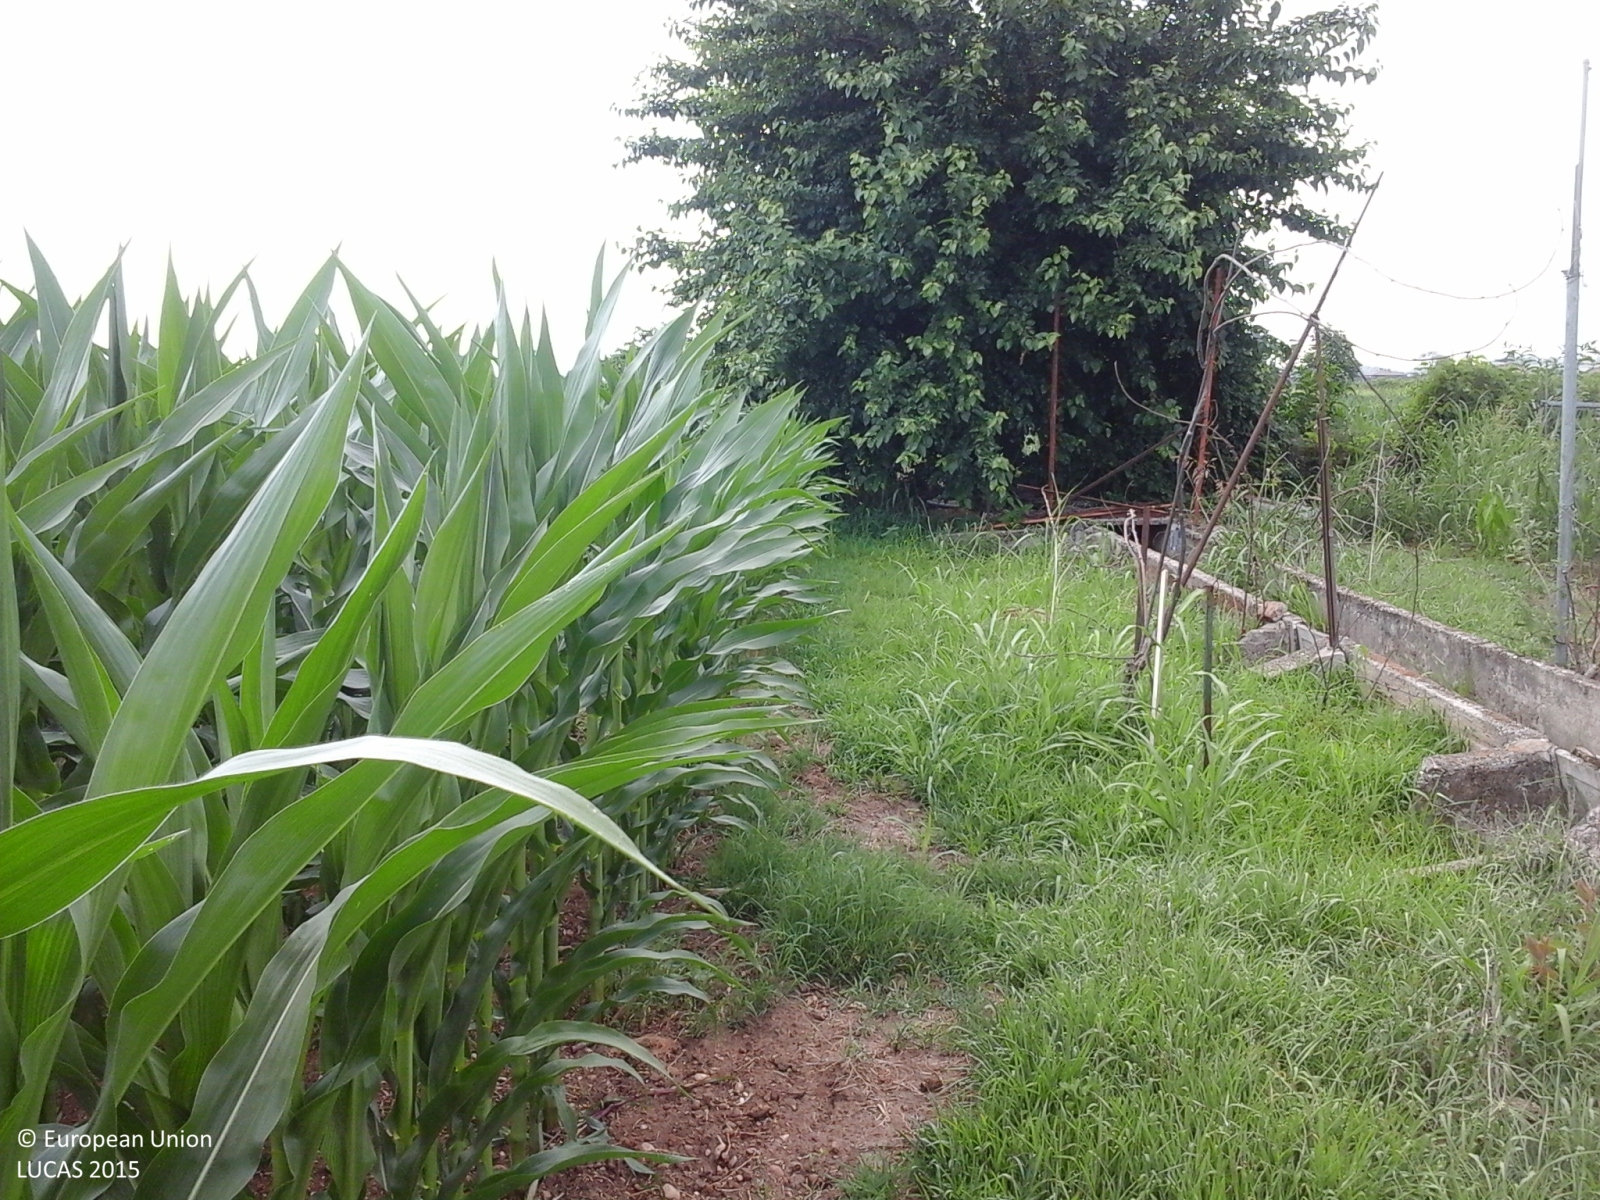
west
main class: Cropland
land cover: Maize
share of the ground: > 75 %
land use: Agriculture (excluding fallow land and kitchen gardens)
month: June
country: IT
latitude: 45.4106
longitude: 10.8801
